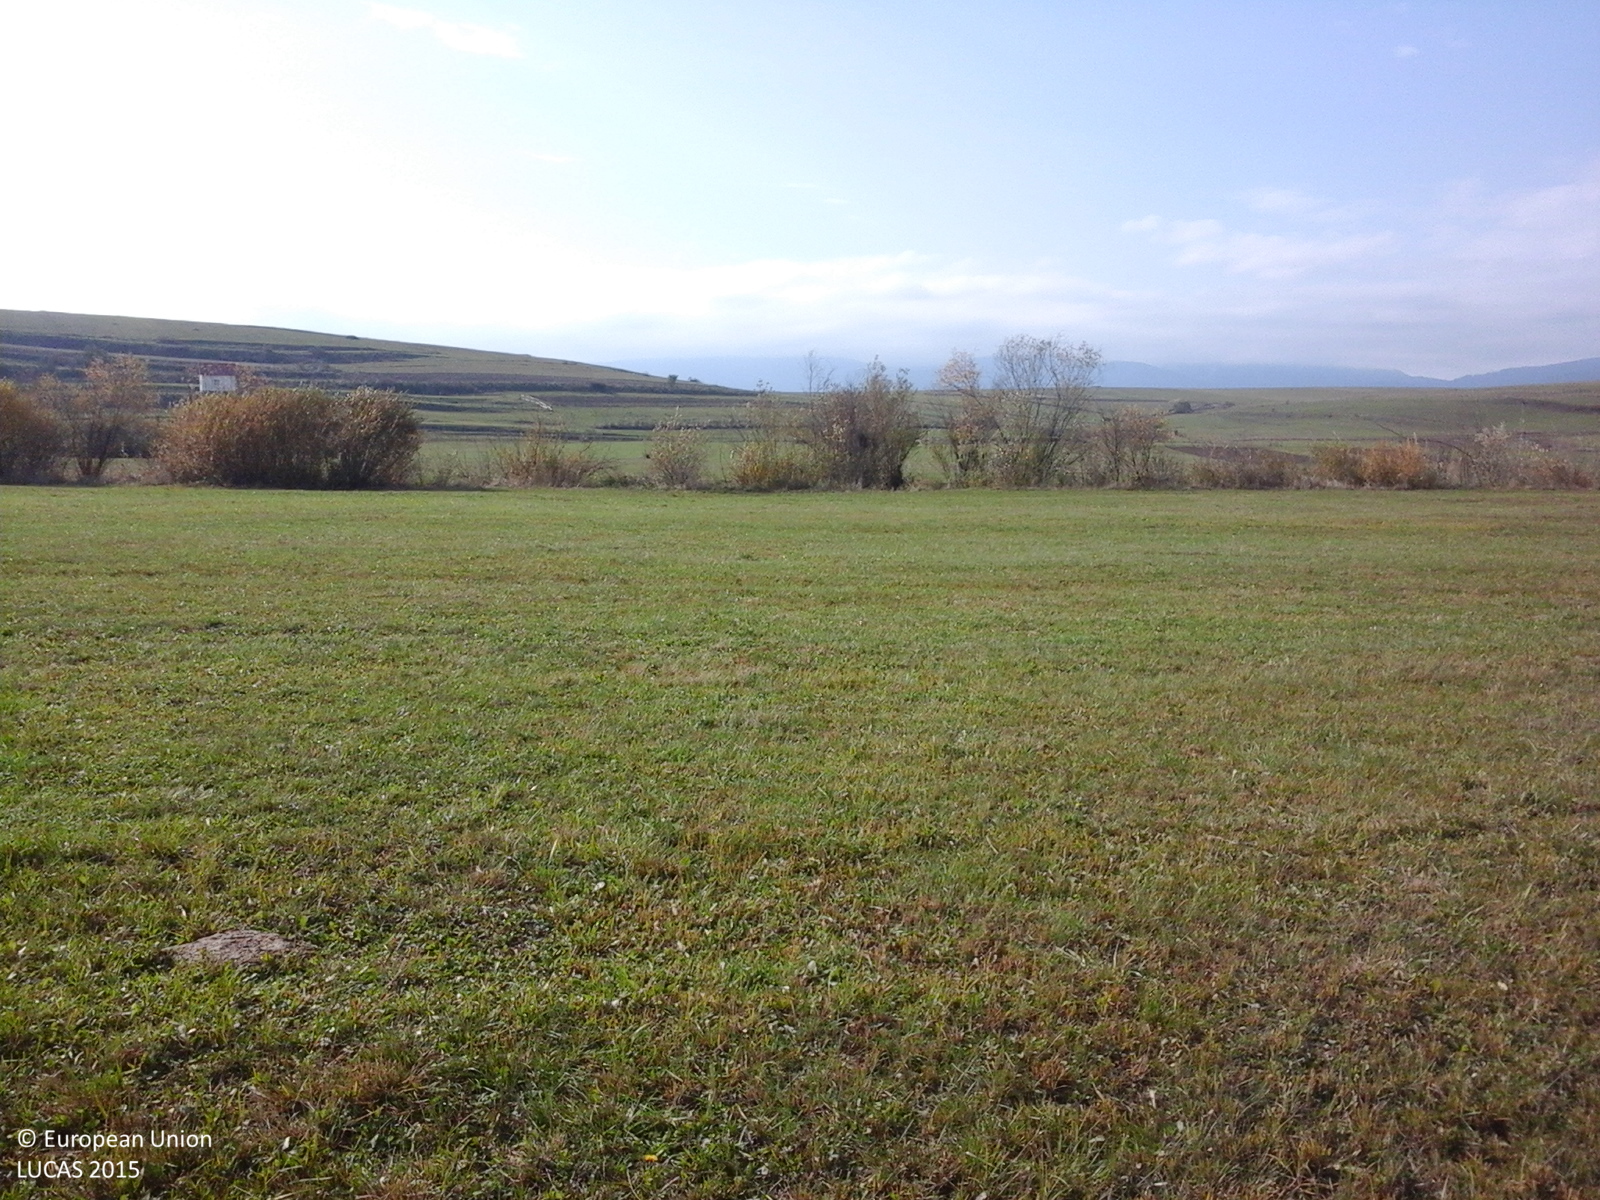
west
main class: Grassland
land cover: Grassland without tree/shrub cover
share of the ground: > 75 %
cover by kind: herbaceous plants 100 %
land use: Agriculture (excluding fallow land and kitchen gardens)
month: October
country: RO
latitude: 46.5148
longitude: 25.7423
